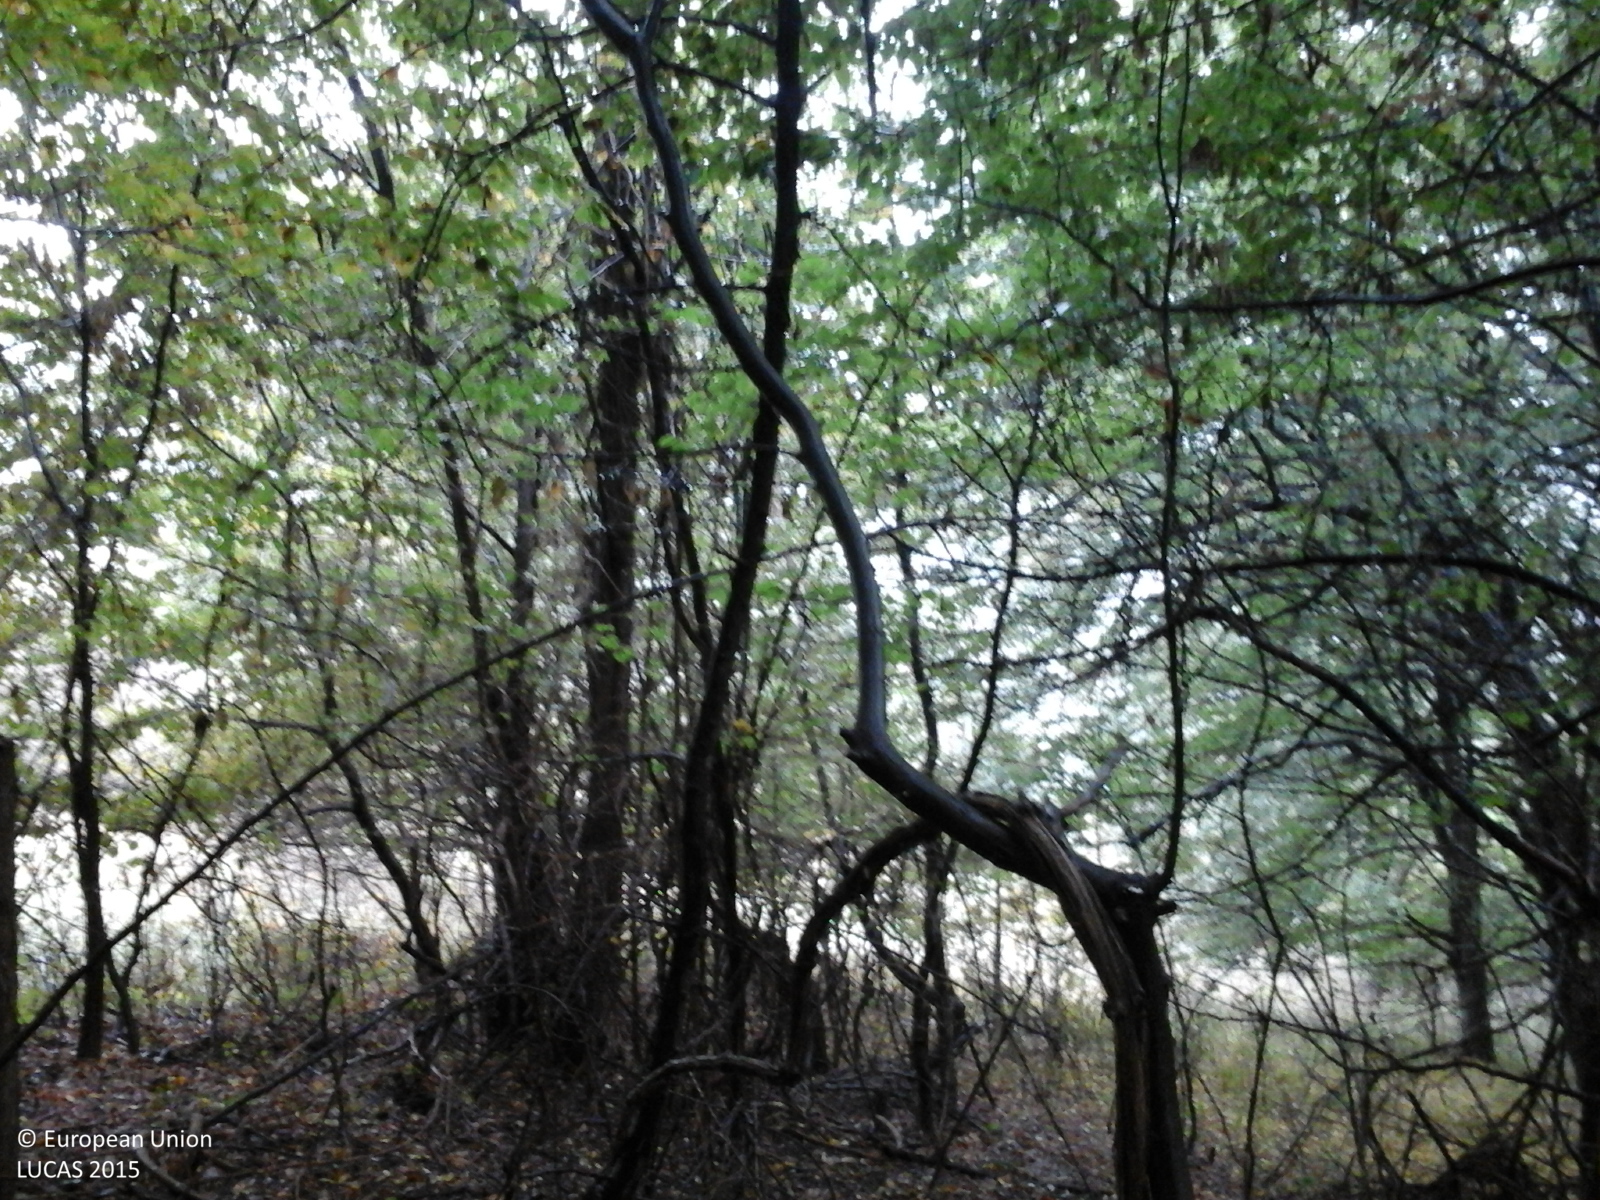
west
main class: Woodland
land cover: Broadleaved woodland
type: mesophytic deciduous forest
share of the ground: > 75 %
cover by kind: broadleaved forest trees 100 %
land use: Forestry
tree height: > 5 m
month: October
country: RO
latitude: 46.2110
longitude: 24.6703
